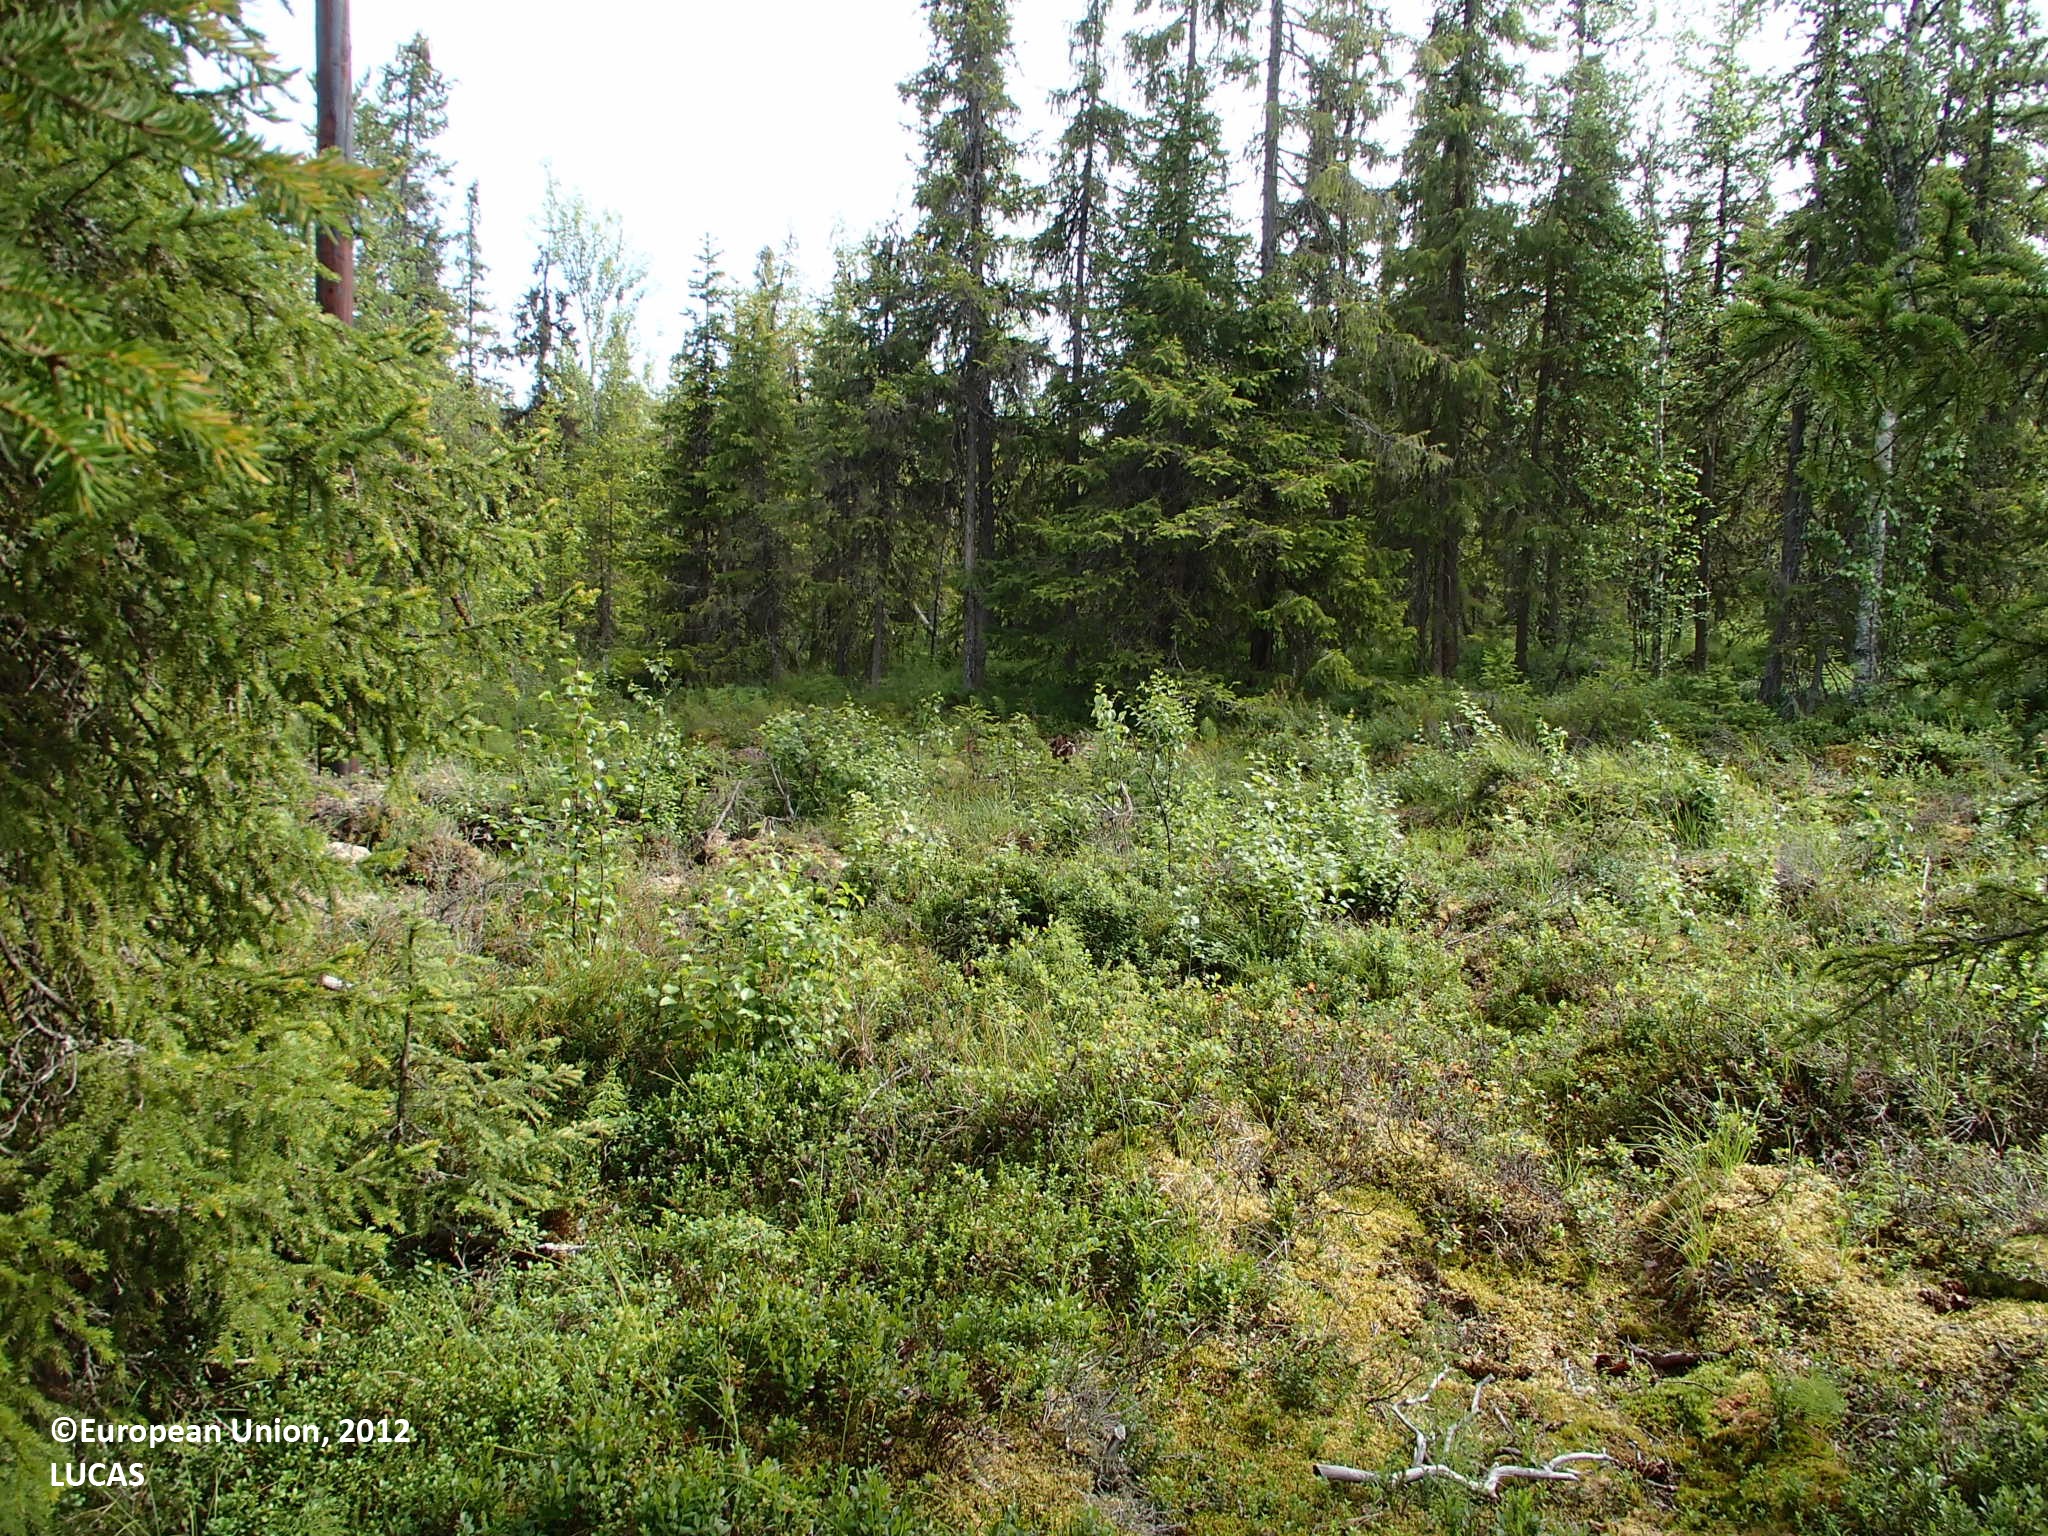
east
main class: Woodland
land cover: Spruce dominated coniferous woodland
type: boreal forest
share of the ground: > 75 %
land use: Forestry
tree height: > 5 m
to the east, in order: Spruce dominated coniferous woodland; Grassland without tree/shrub cover; Electric lines; Grassland without tree/shrub cover; Spruce dominated coniferous woodland; Other coniferous woodland; Other mixed woodland; Ditches and canals; Other mixed woodland; Fences; Pine dominated coniferous woodland; Other mixed woodland
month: July
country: FI
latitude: 66.4477
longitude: 25.6547
